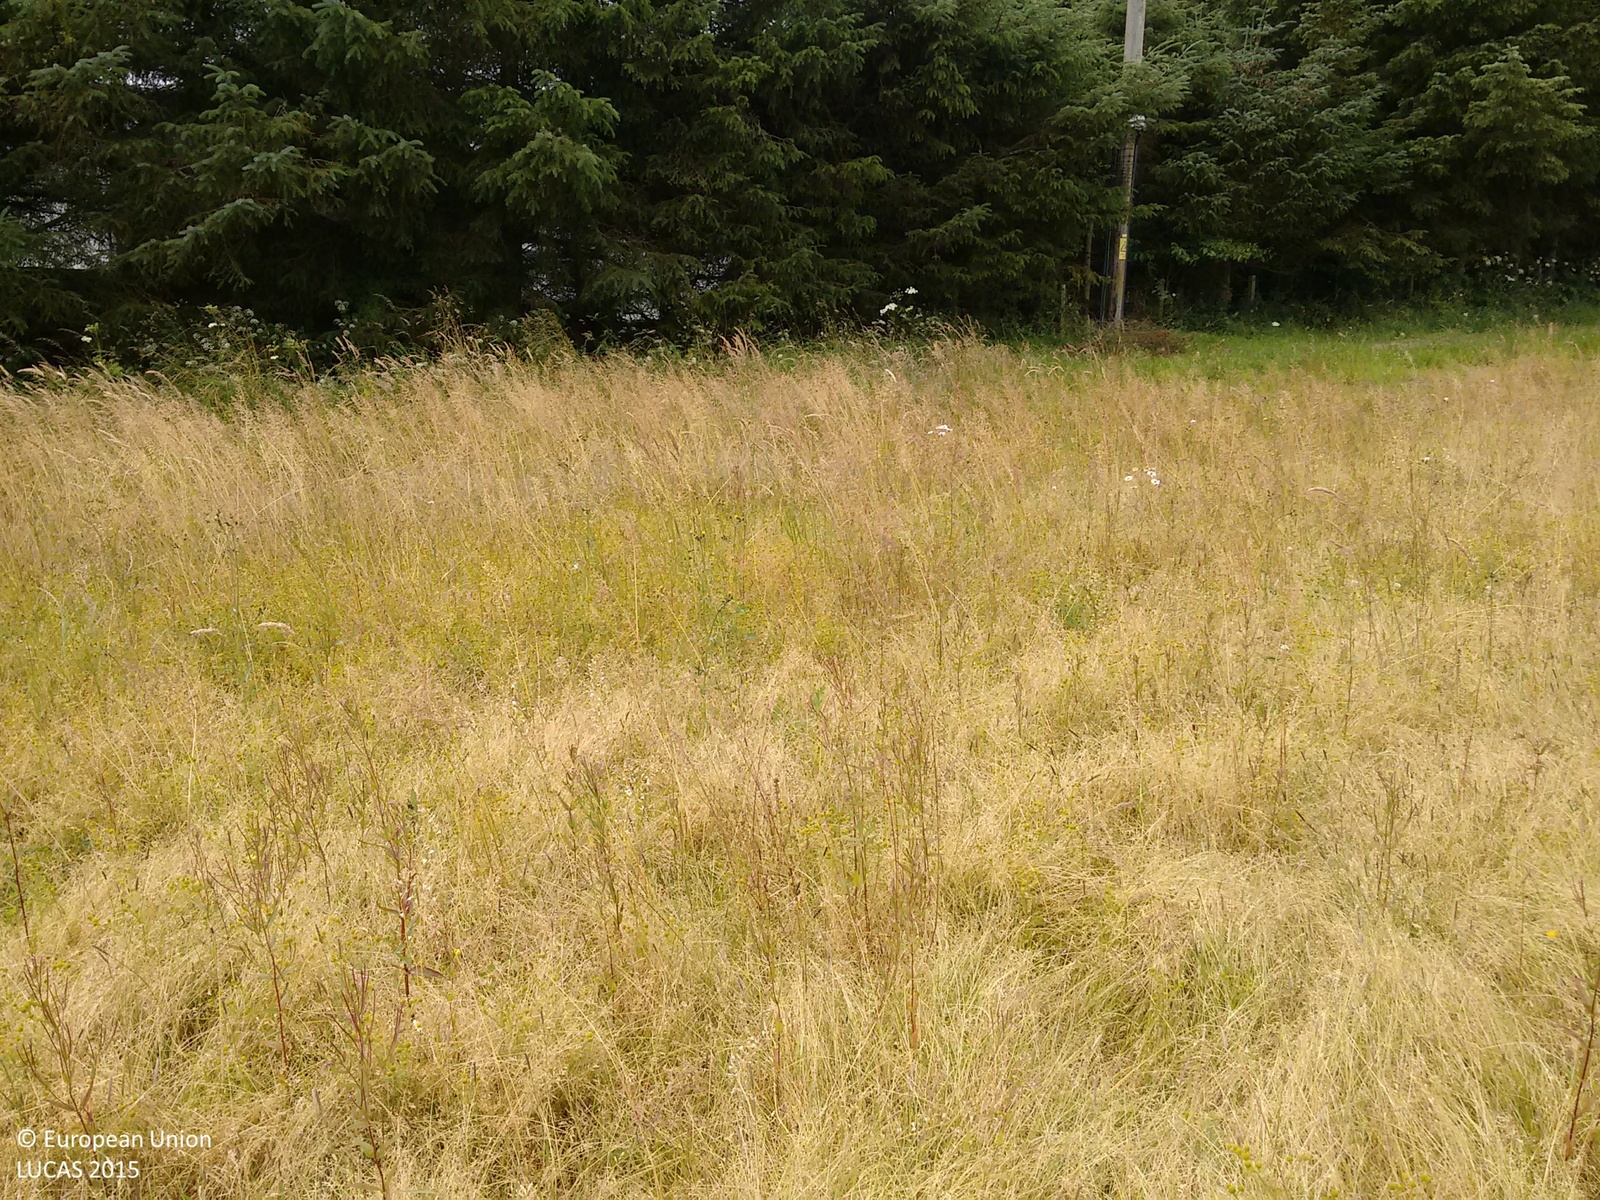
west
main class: Cropland
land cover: Rape and turnip rape
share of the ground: > 75 %
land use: Agriculture (excluding fallow land and kitchen gardens)
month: July
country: GB
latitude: 57.6043
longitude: -2.4181
